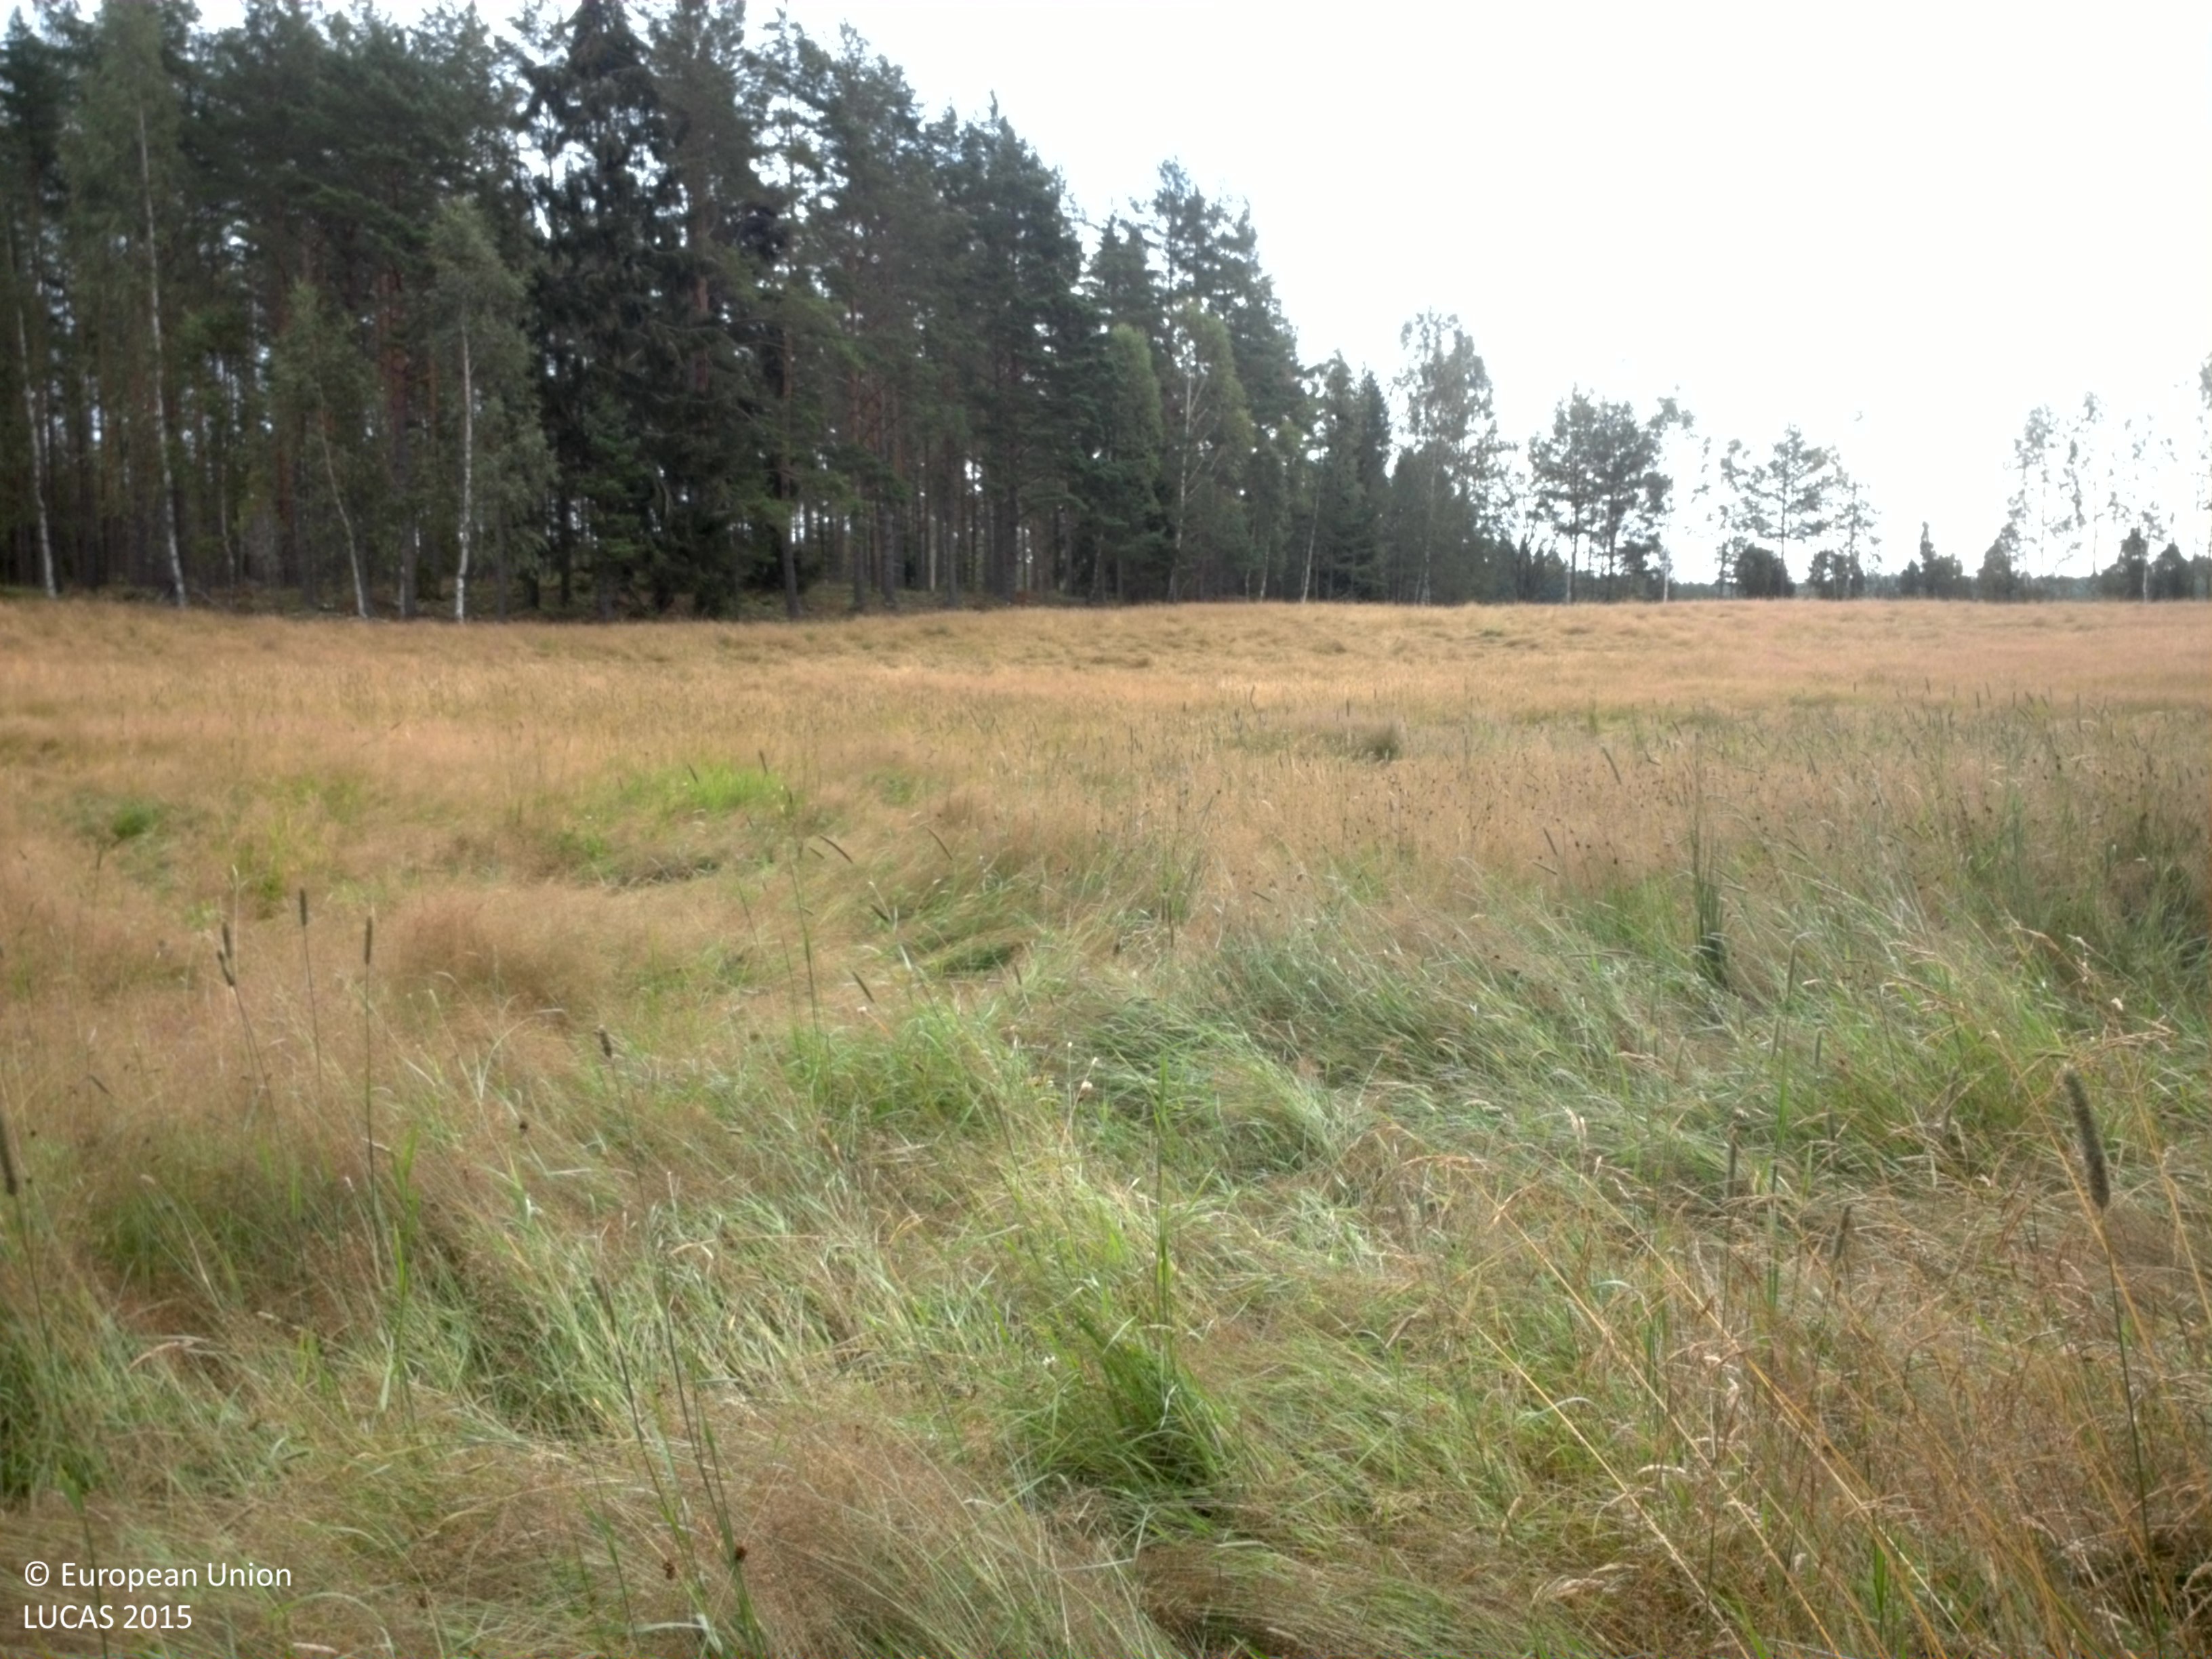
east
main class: Cropland
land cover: Temporary grasslands
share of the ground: > 75 %
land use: Agriculture (excluding fallow land and kitchen gardens)
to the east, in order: Temporary grasslands; Pine dominated coniferous woodland; Tracks; Pine dominated coniferous woodland; Tracks; Pine dominated coniferous woodland; Rivers and streams; Shrubland with sparse tree cover
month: August
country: SE
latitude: 59.3216
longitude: 11.9104
